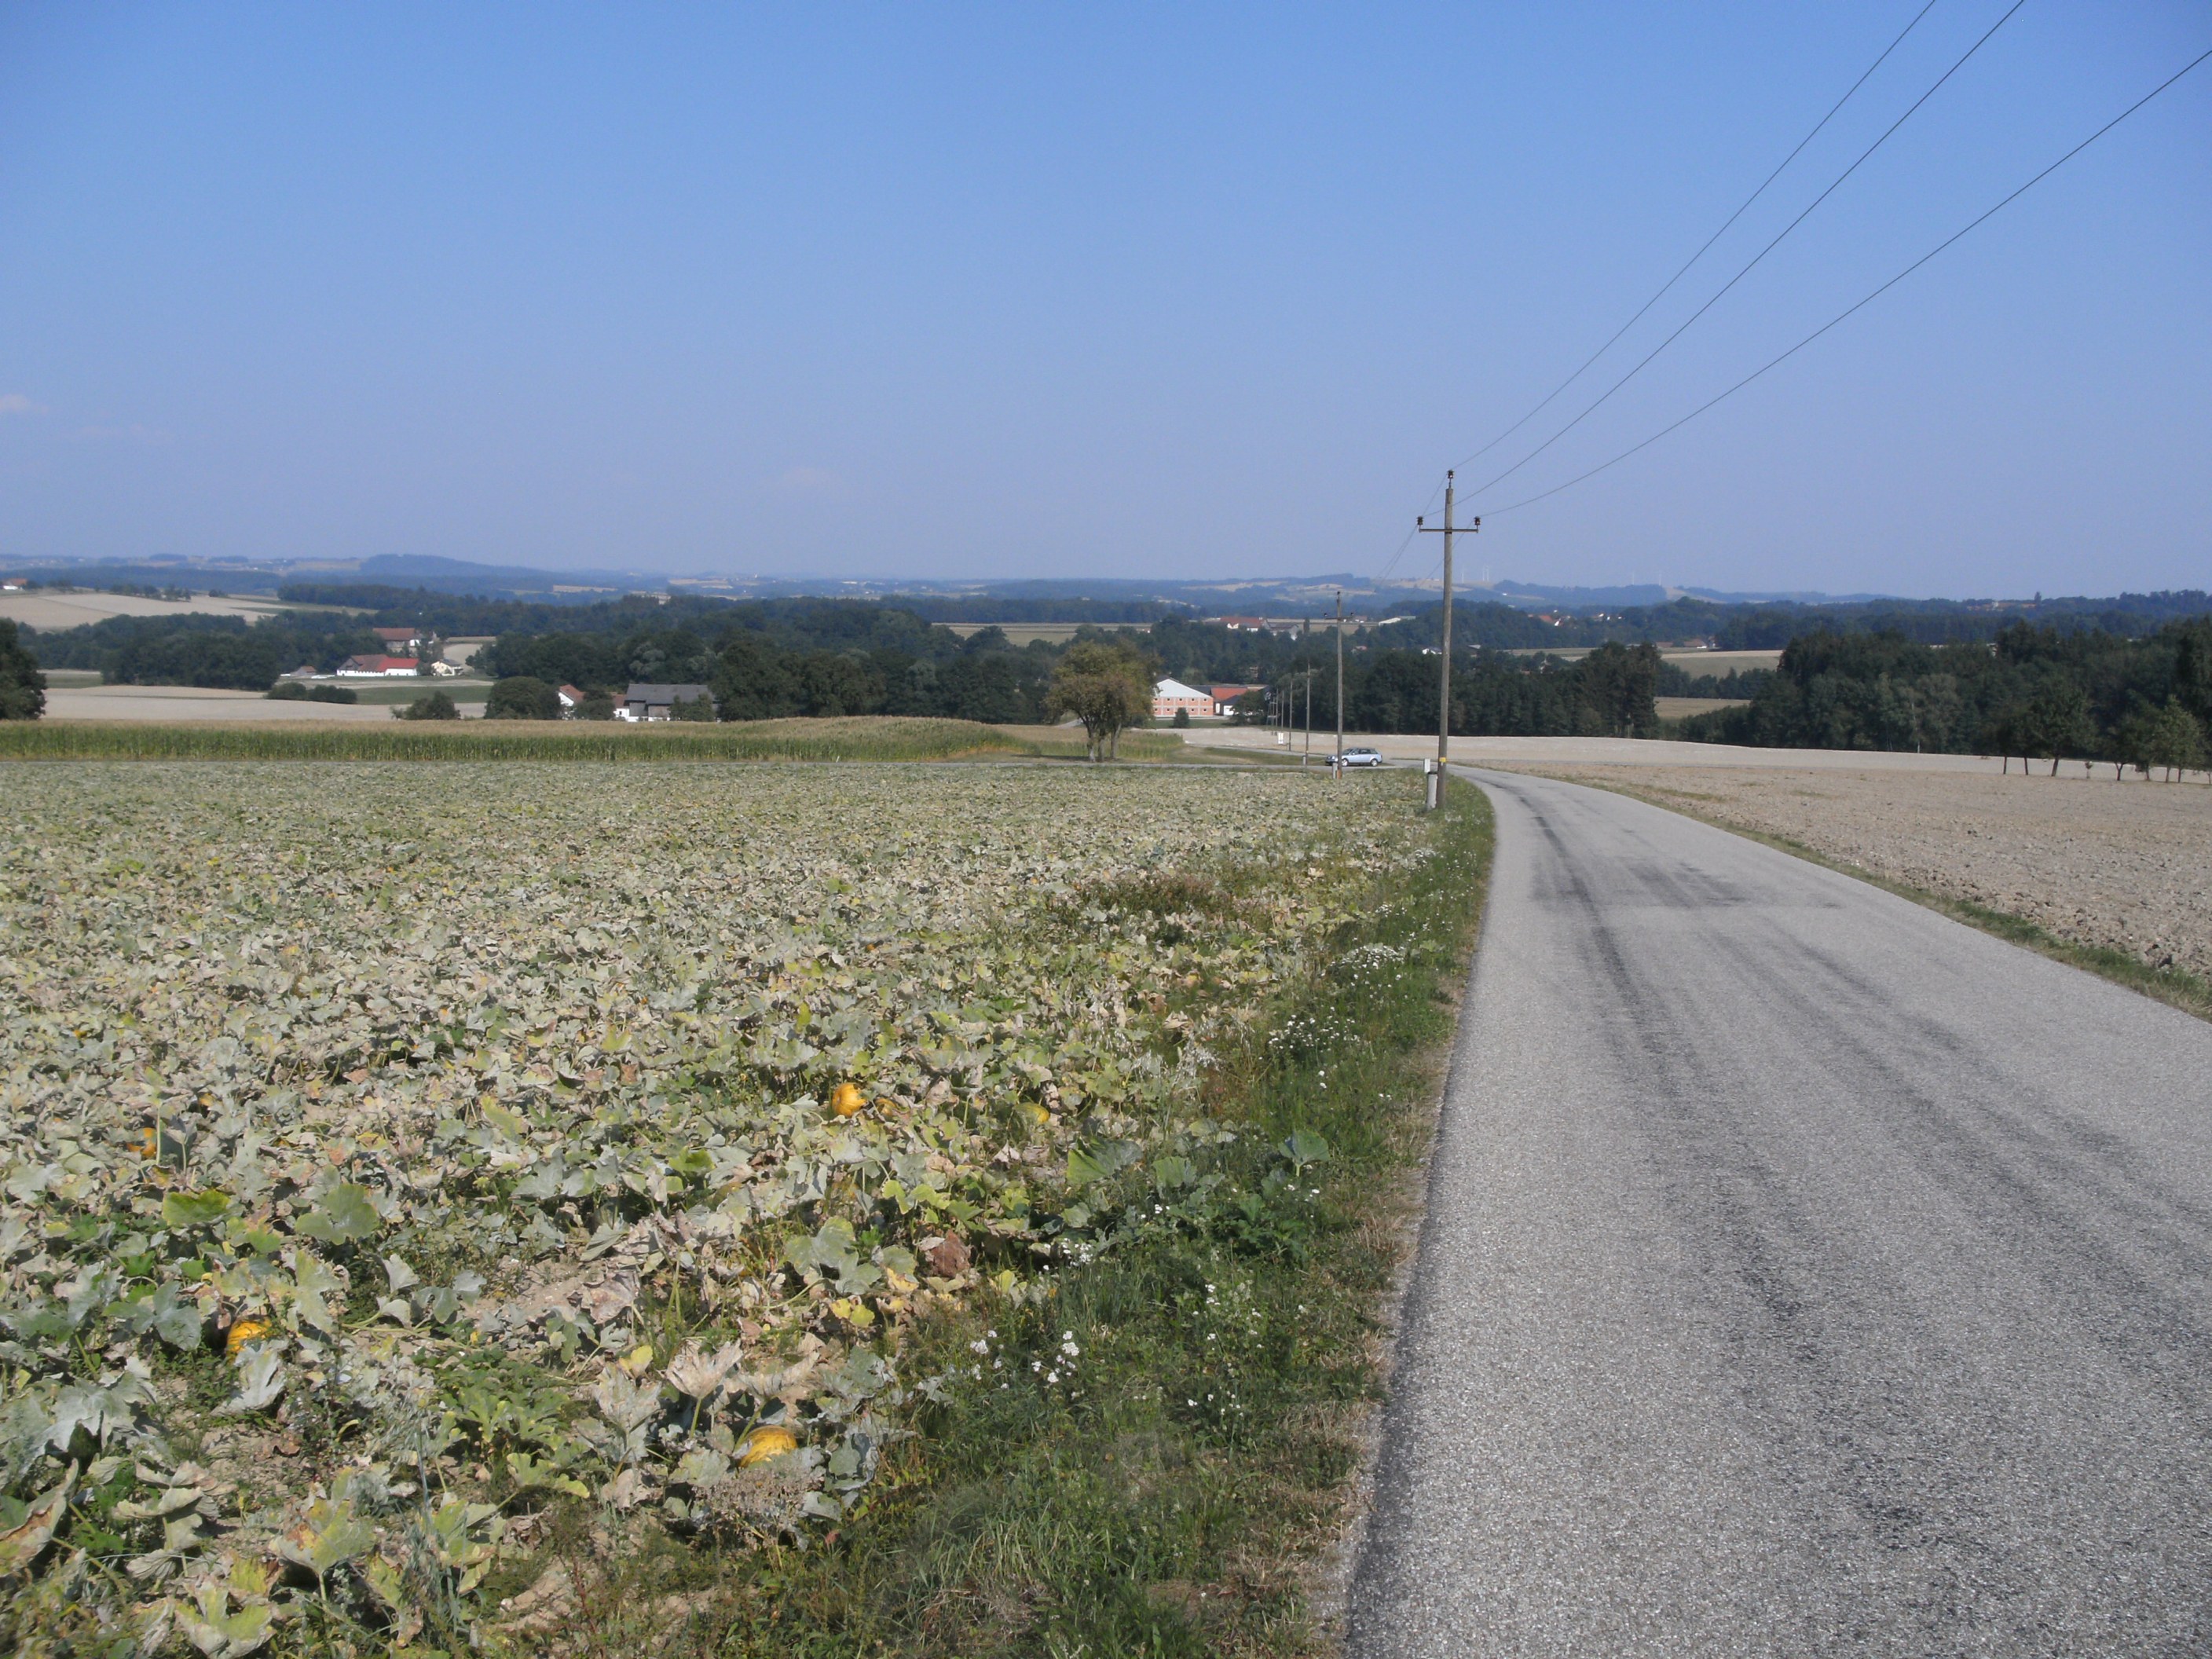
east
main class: Cropland
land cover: Other fresh vegetables
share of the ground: > 75 %
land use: Agriculture (excluding fallow land and kitchen gardens)
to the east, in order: Other fresh vegetables; Grass margins; Paved roads, cycling and walking lanes; Grass margins; Maize; Grassland without tree/shrub cover
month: August
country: AT
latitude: 48.3475
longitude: 13.5212
